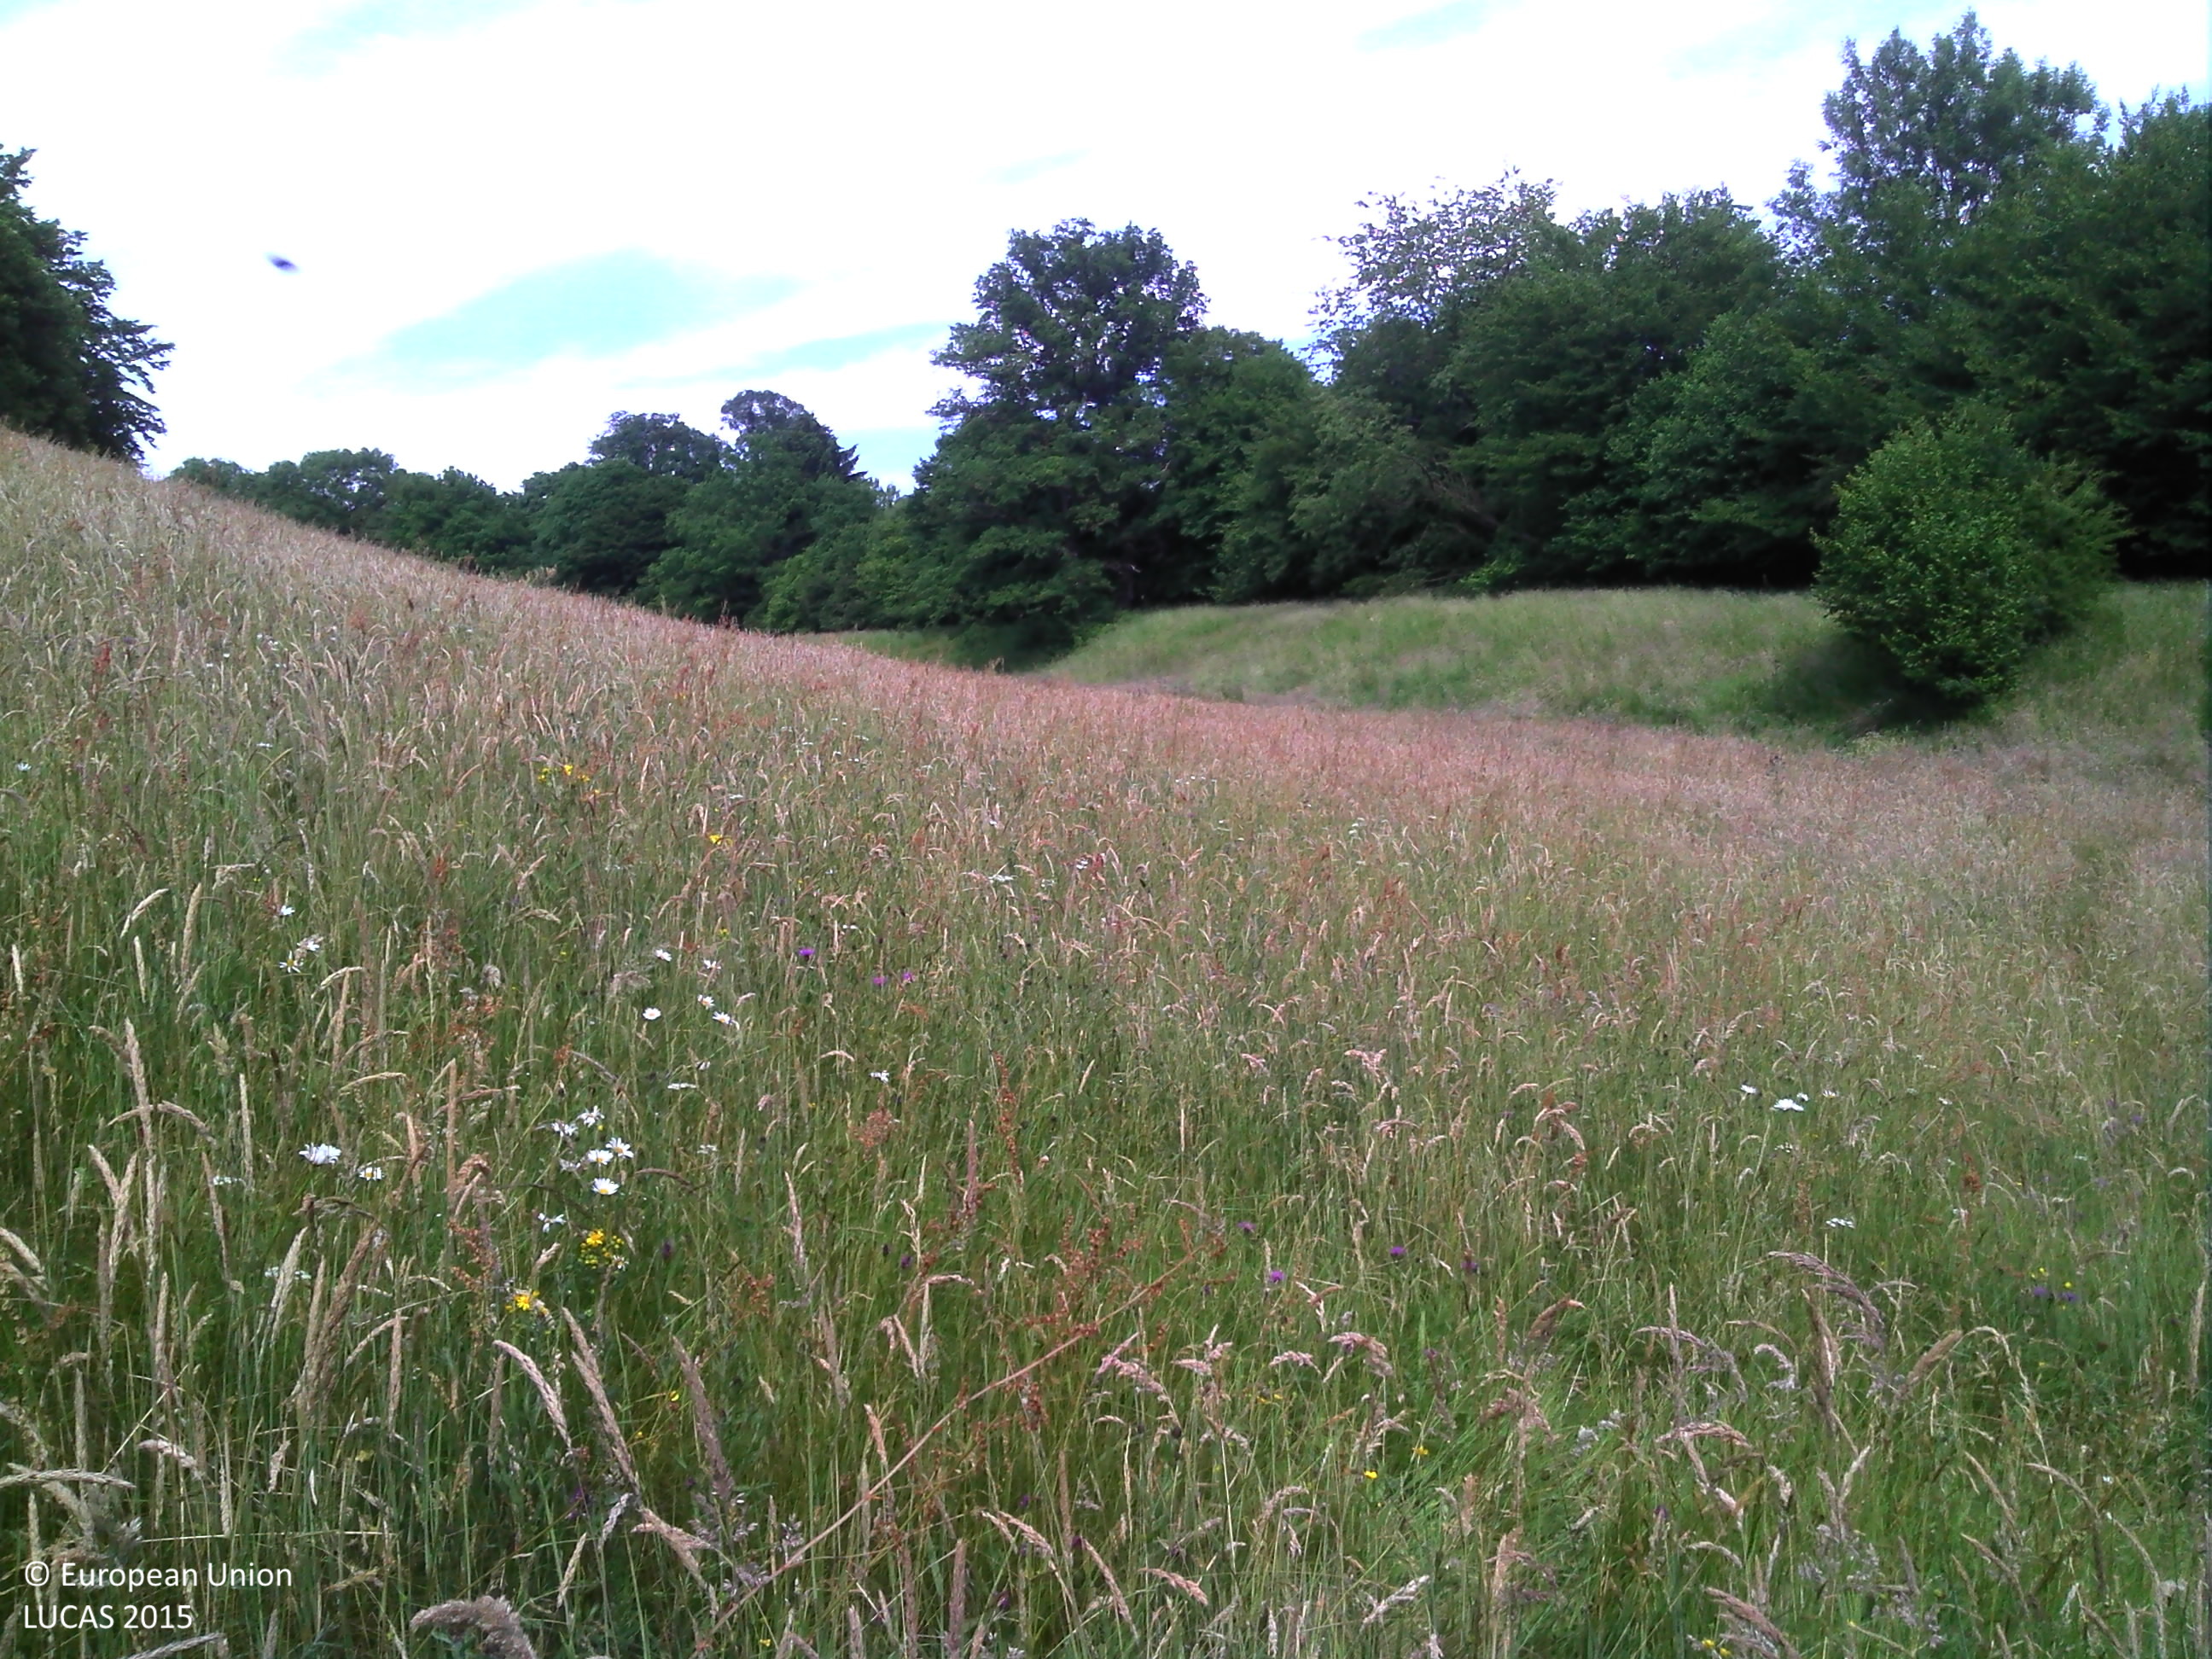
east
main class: Grassland
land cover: Grassland without tree/shrub cover
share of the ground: > 75 %
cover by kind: herbaceous plants 100 %
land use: Agriculture (excluding fallow land and kitchen gardens)
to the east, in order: Grassland without tree/shrub cover; Single bushes/trees; Grassland without tree/shrub cover; Fences; Broadleaved woodland; Rivers and streams; Tracks; Broadleaved woodland; Fences; Grassland without tree/shrub cover; Fences; Grass margins; Paved roads, cycling and walking lanes; Grass margins; Broadleaved woodland; Fences; Grassland without tree/shrub cover; Fences; Grassland without tree/shrub cover
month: June
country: BE
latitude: 50.3937
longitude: 5.7646
